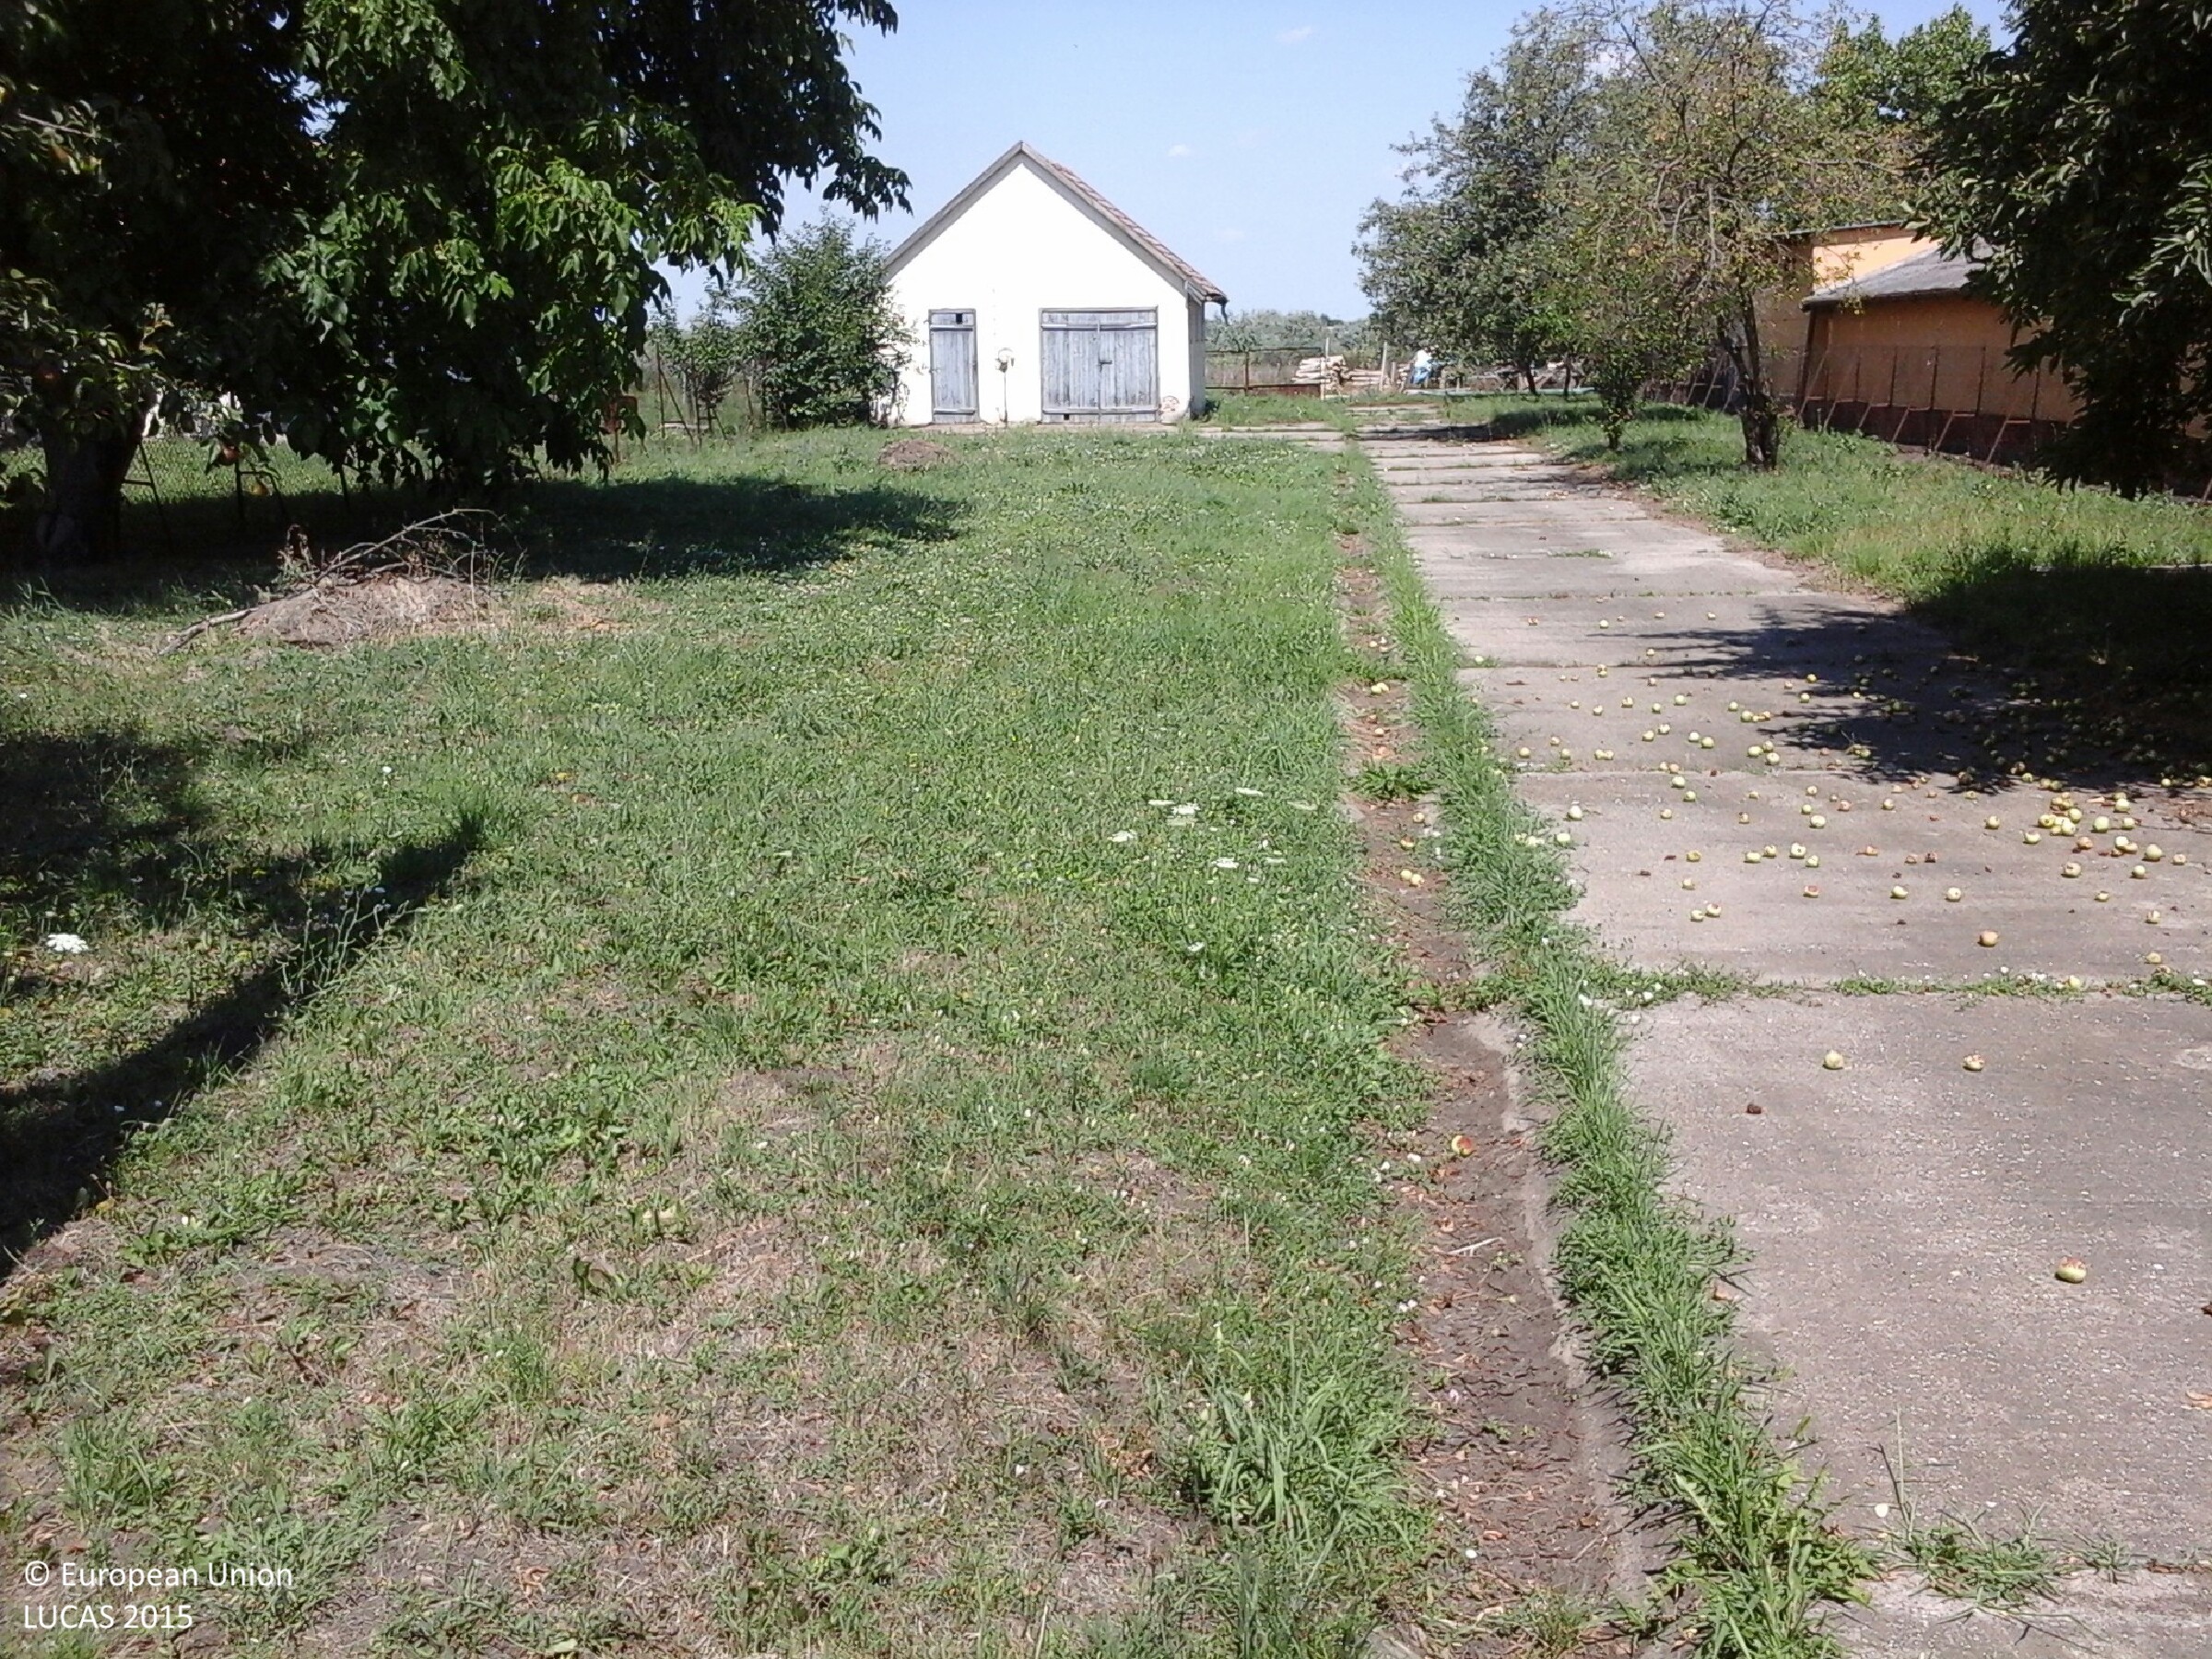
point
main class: Grassland
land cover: Grassland without tree/shrub cover
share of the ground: > 75 %
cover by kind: herbaceous plants 100 %
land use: Residential
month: July
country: HU
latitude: 47.6522
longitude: 20.6442
